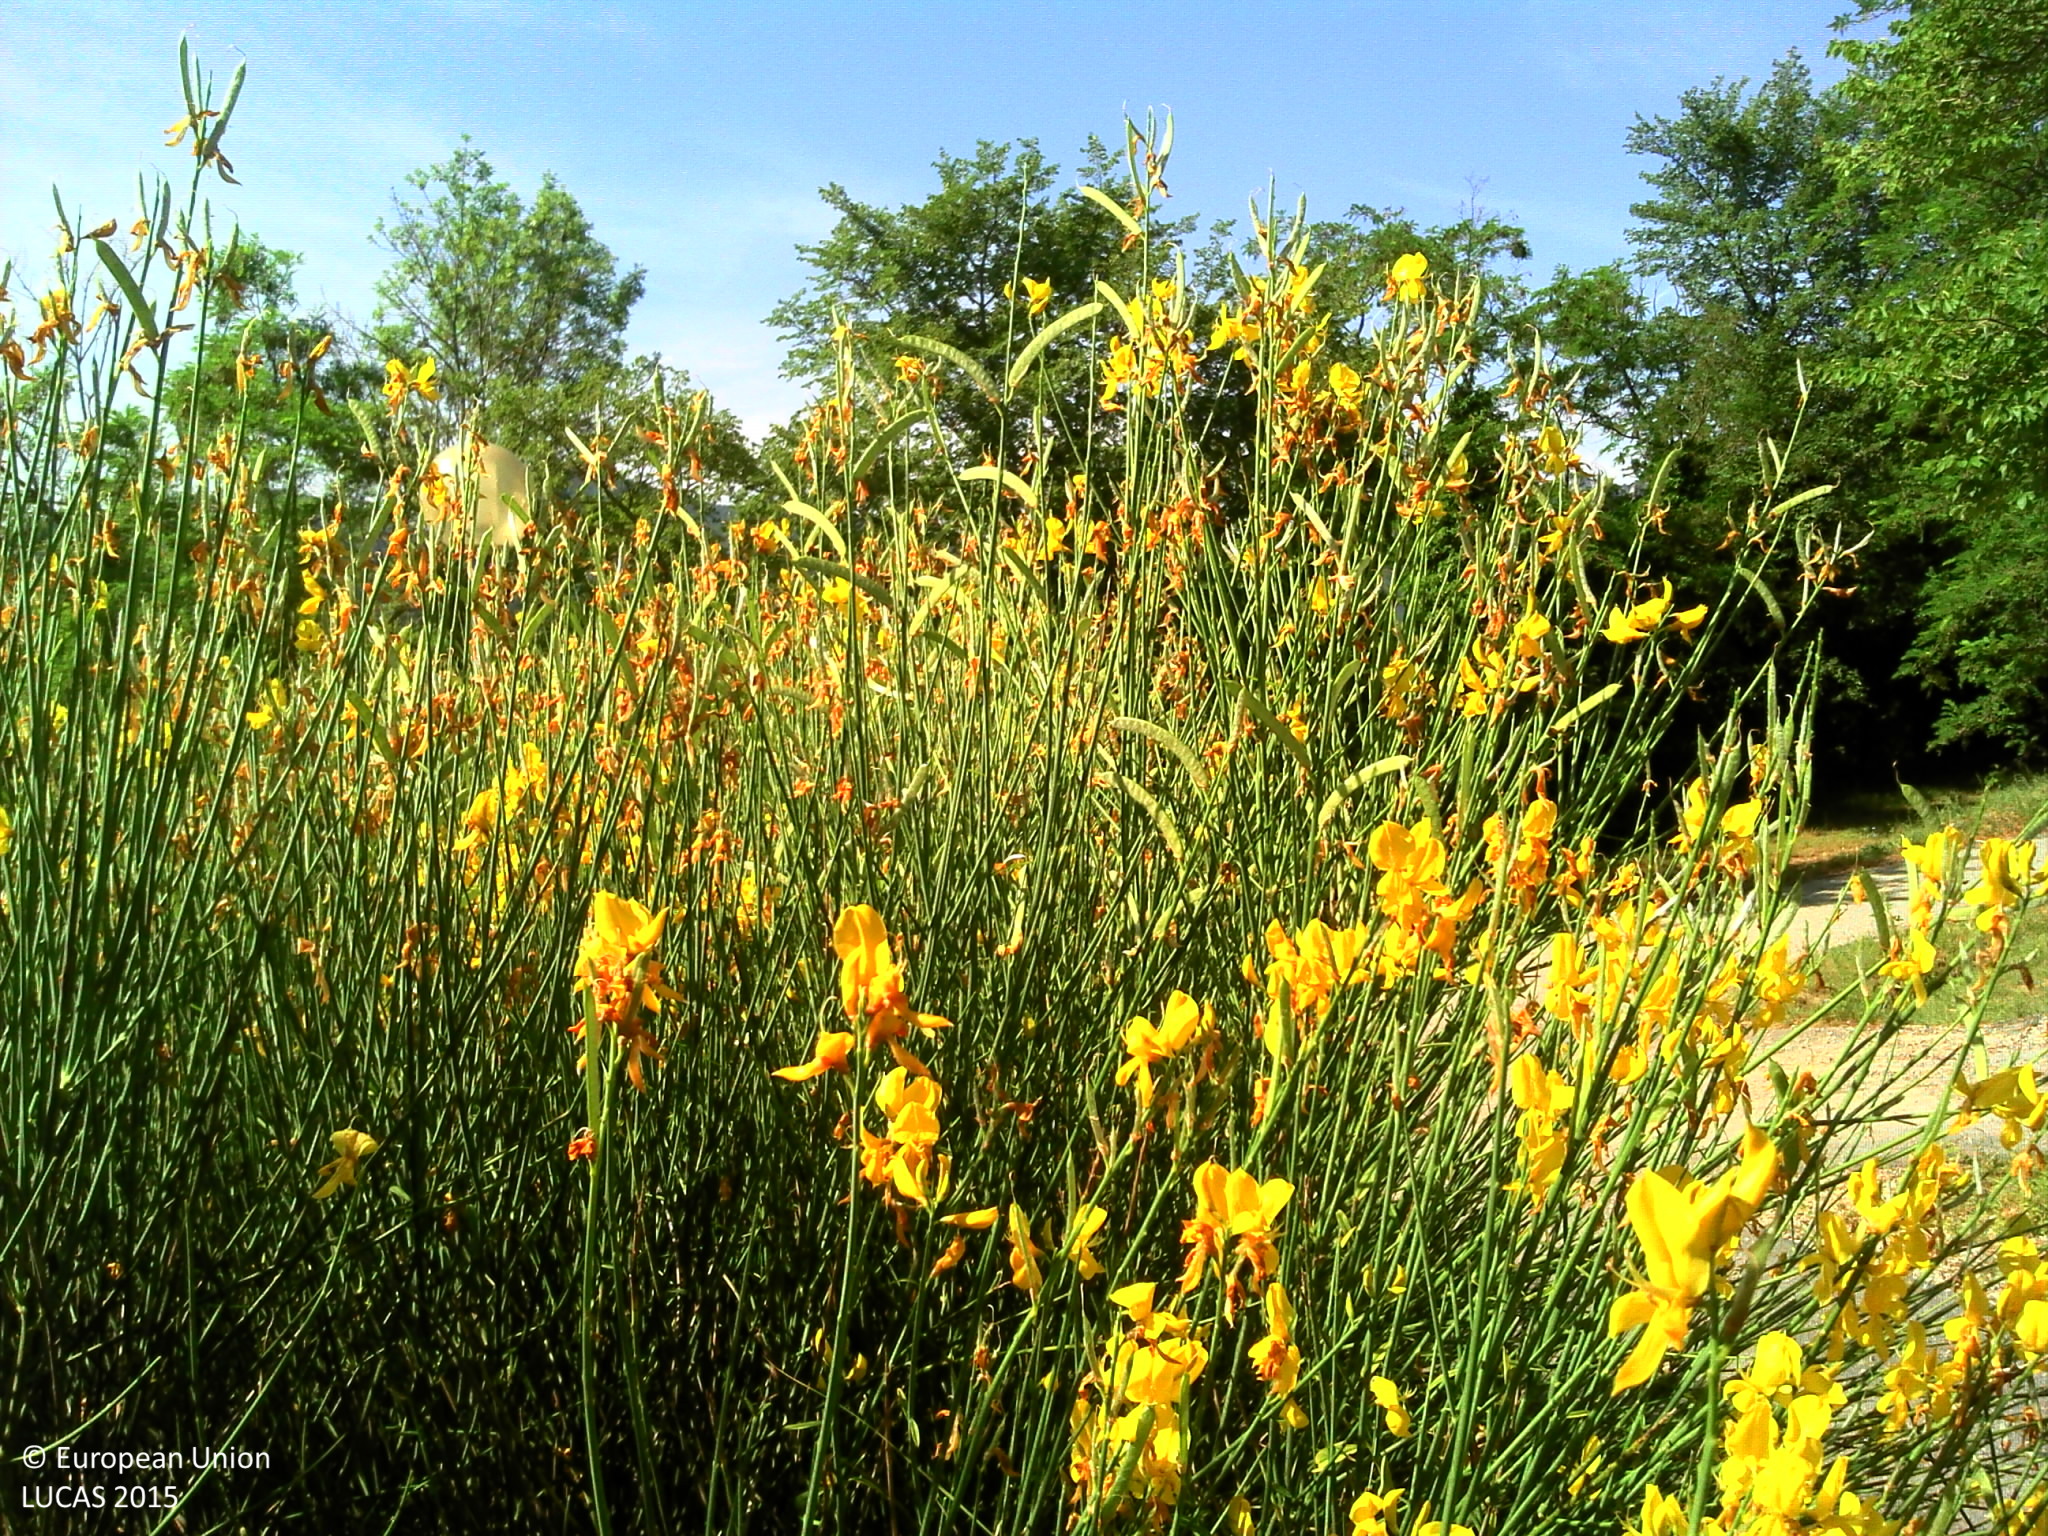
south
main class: Shrubland
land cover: Shrubland with sparse tree cover
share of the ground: > 75 %
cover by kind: herbaceous plants 85 %, shrubs 10 %, broadleaved forest trees 5 %
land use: Residential
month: June
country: FR
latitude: 44.7113
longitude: 5.2477
